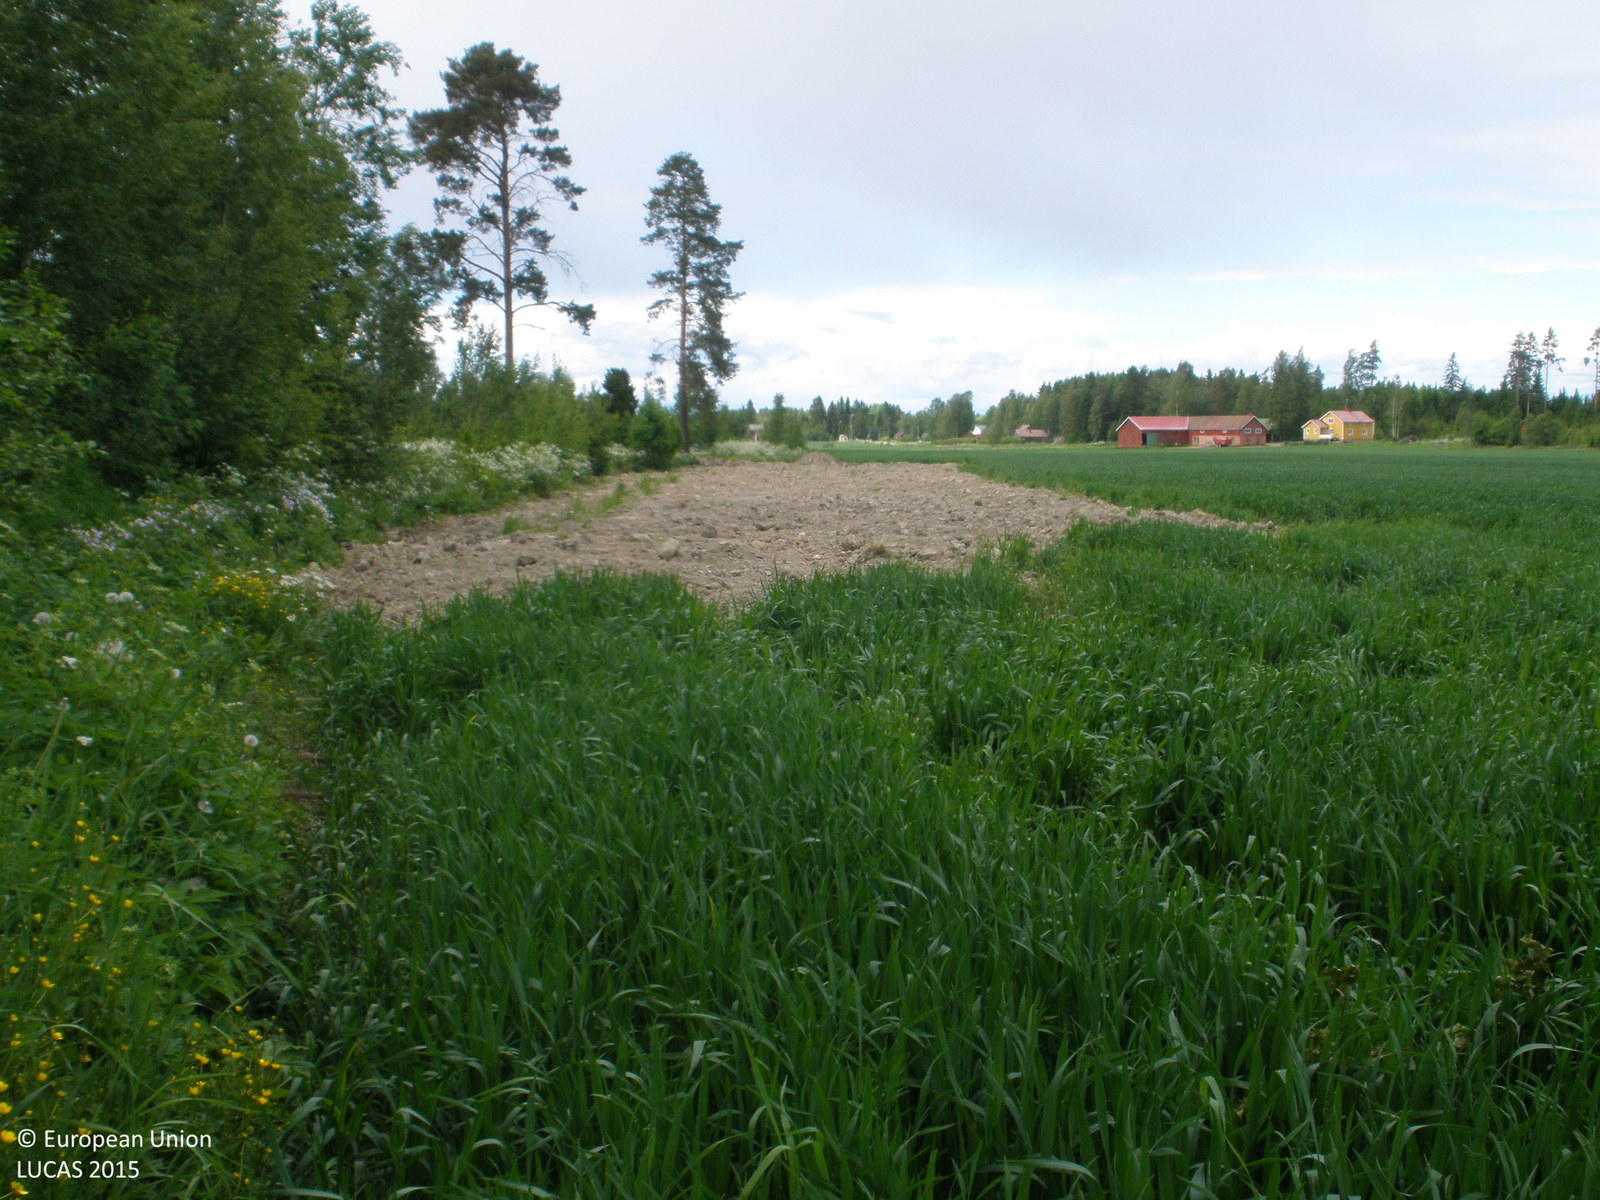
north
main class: Cropland
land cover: Common wheat
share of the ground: > 75 %
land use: Agriculture (excluding fallow land and kitchen gardens)
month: June
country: FI
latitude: 61.1090
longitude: 24.5568
